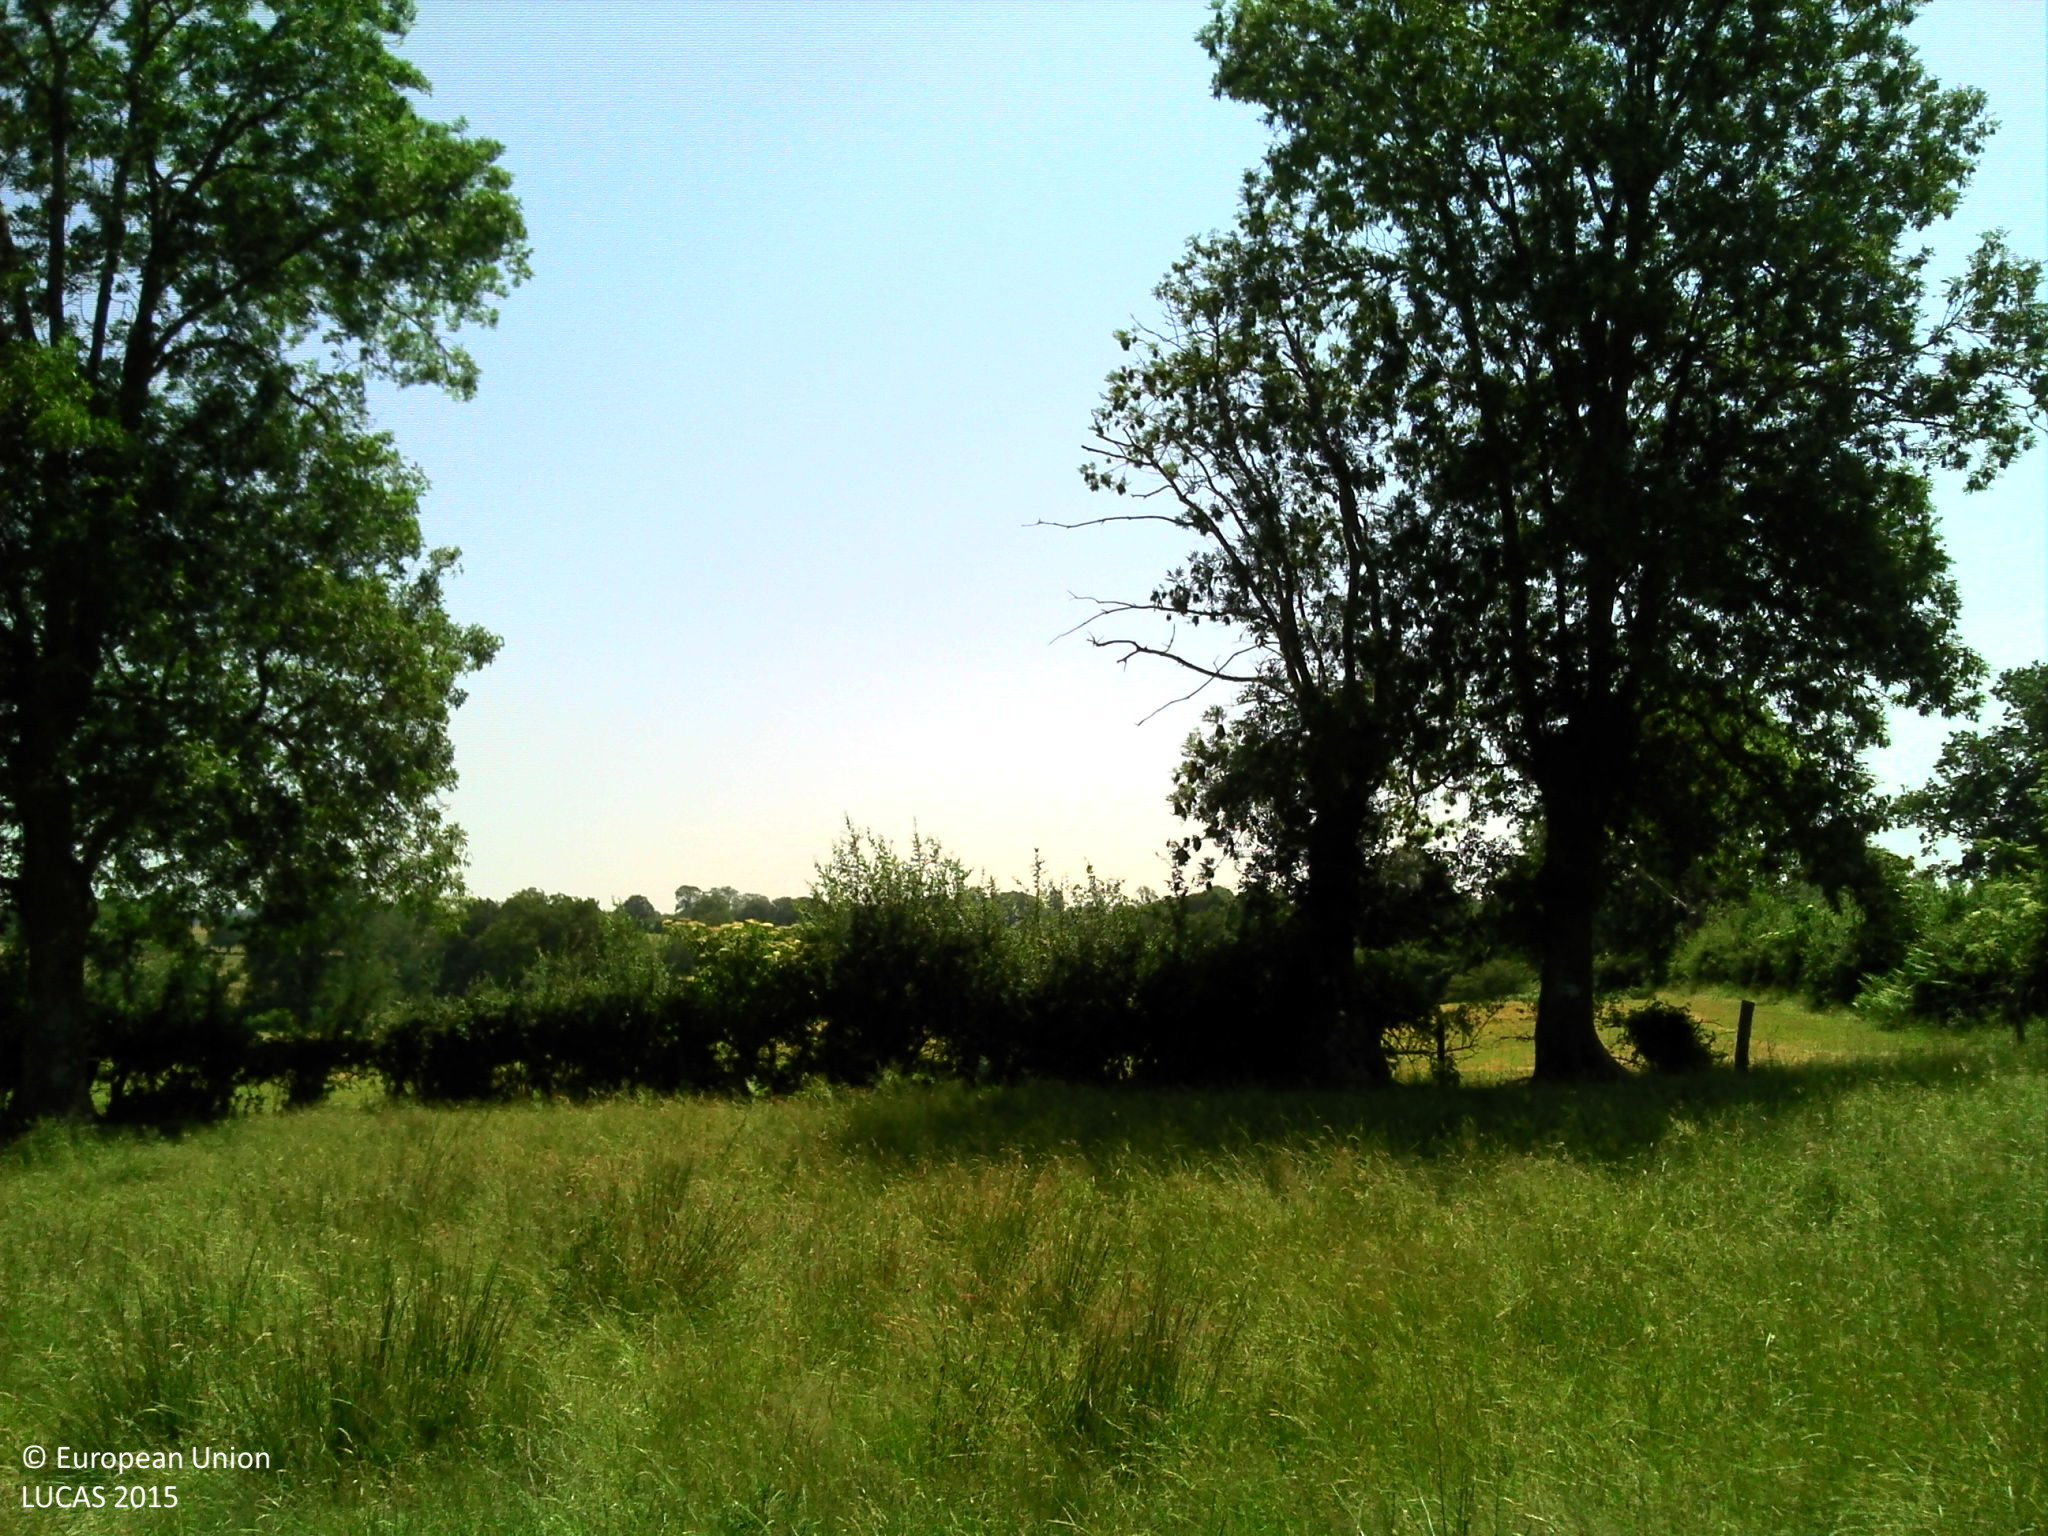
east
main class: Grassland
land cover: Grassland without tree/shrub cover
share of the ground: > 75 %
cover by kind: herbaceous plants 100 %
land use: Agriculture (excluding fallow land and kitchen gardens)
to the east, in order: Grassland without tree/shrub cover; Managed hedges; Fences; Grassland without tree/shrub cover; Fences; Abandoned hedges; Spontaneously vegetated surfaces; Rivers and streams; Spontaneously vegetated surfaces; Grassland with sparse tree/shrub cover
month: June
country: FR
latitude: 46.3742
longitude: 2.9903
